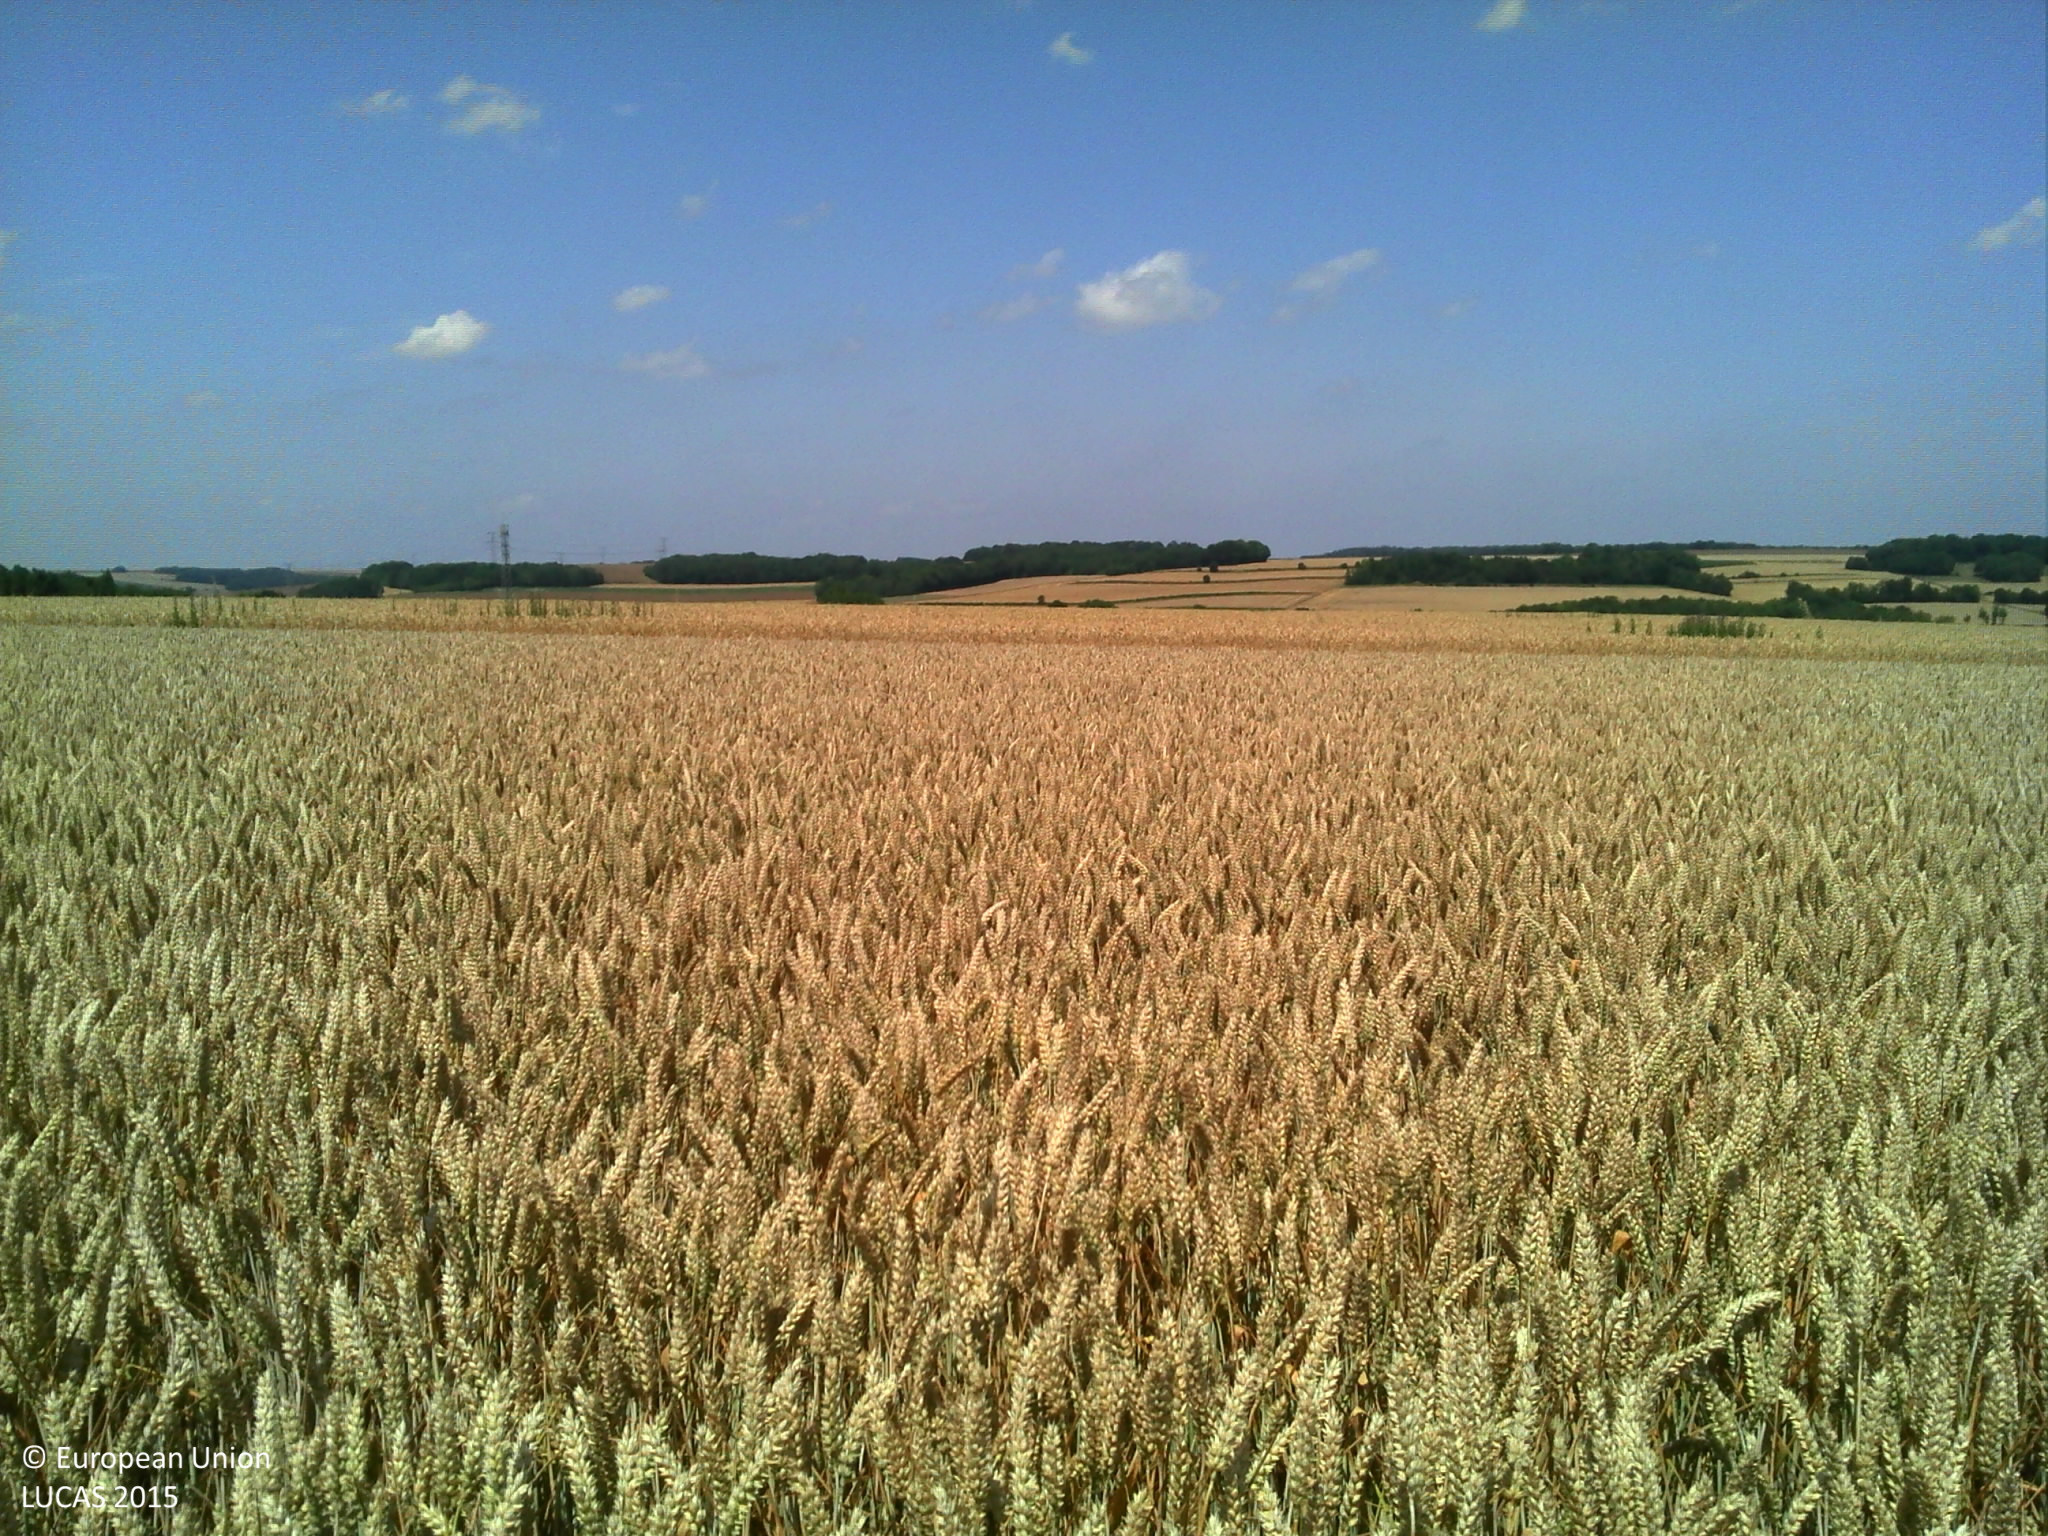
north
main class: Cropland
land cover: Common wheat
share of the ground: > 75 %
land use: Agriculture (excluding fallow land and kitchen gardens)
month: July
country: FR
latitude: 50.0279
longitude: 2.2387
